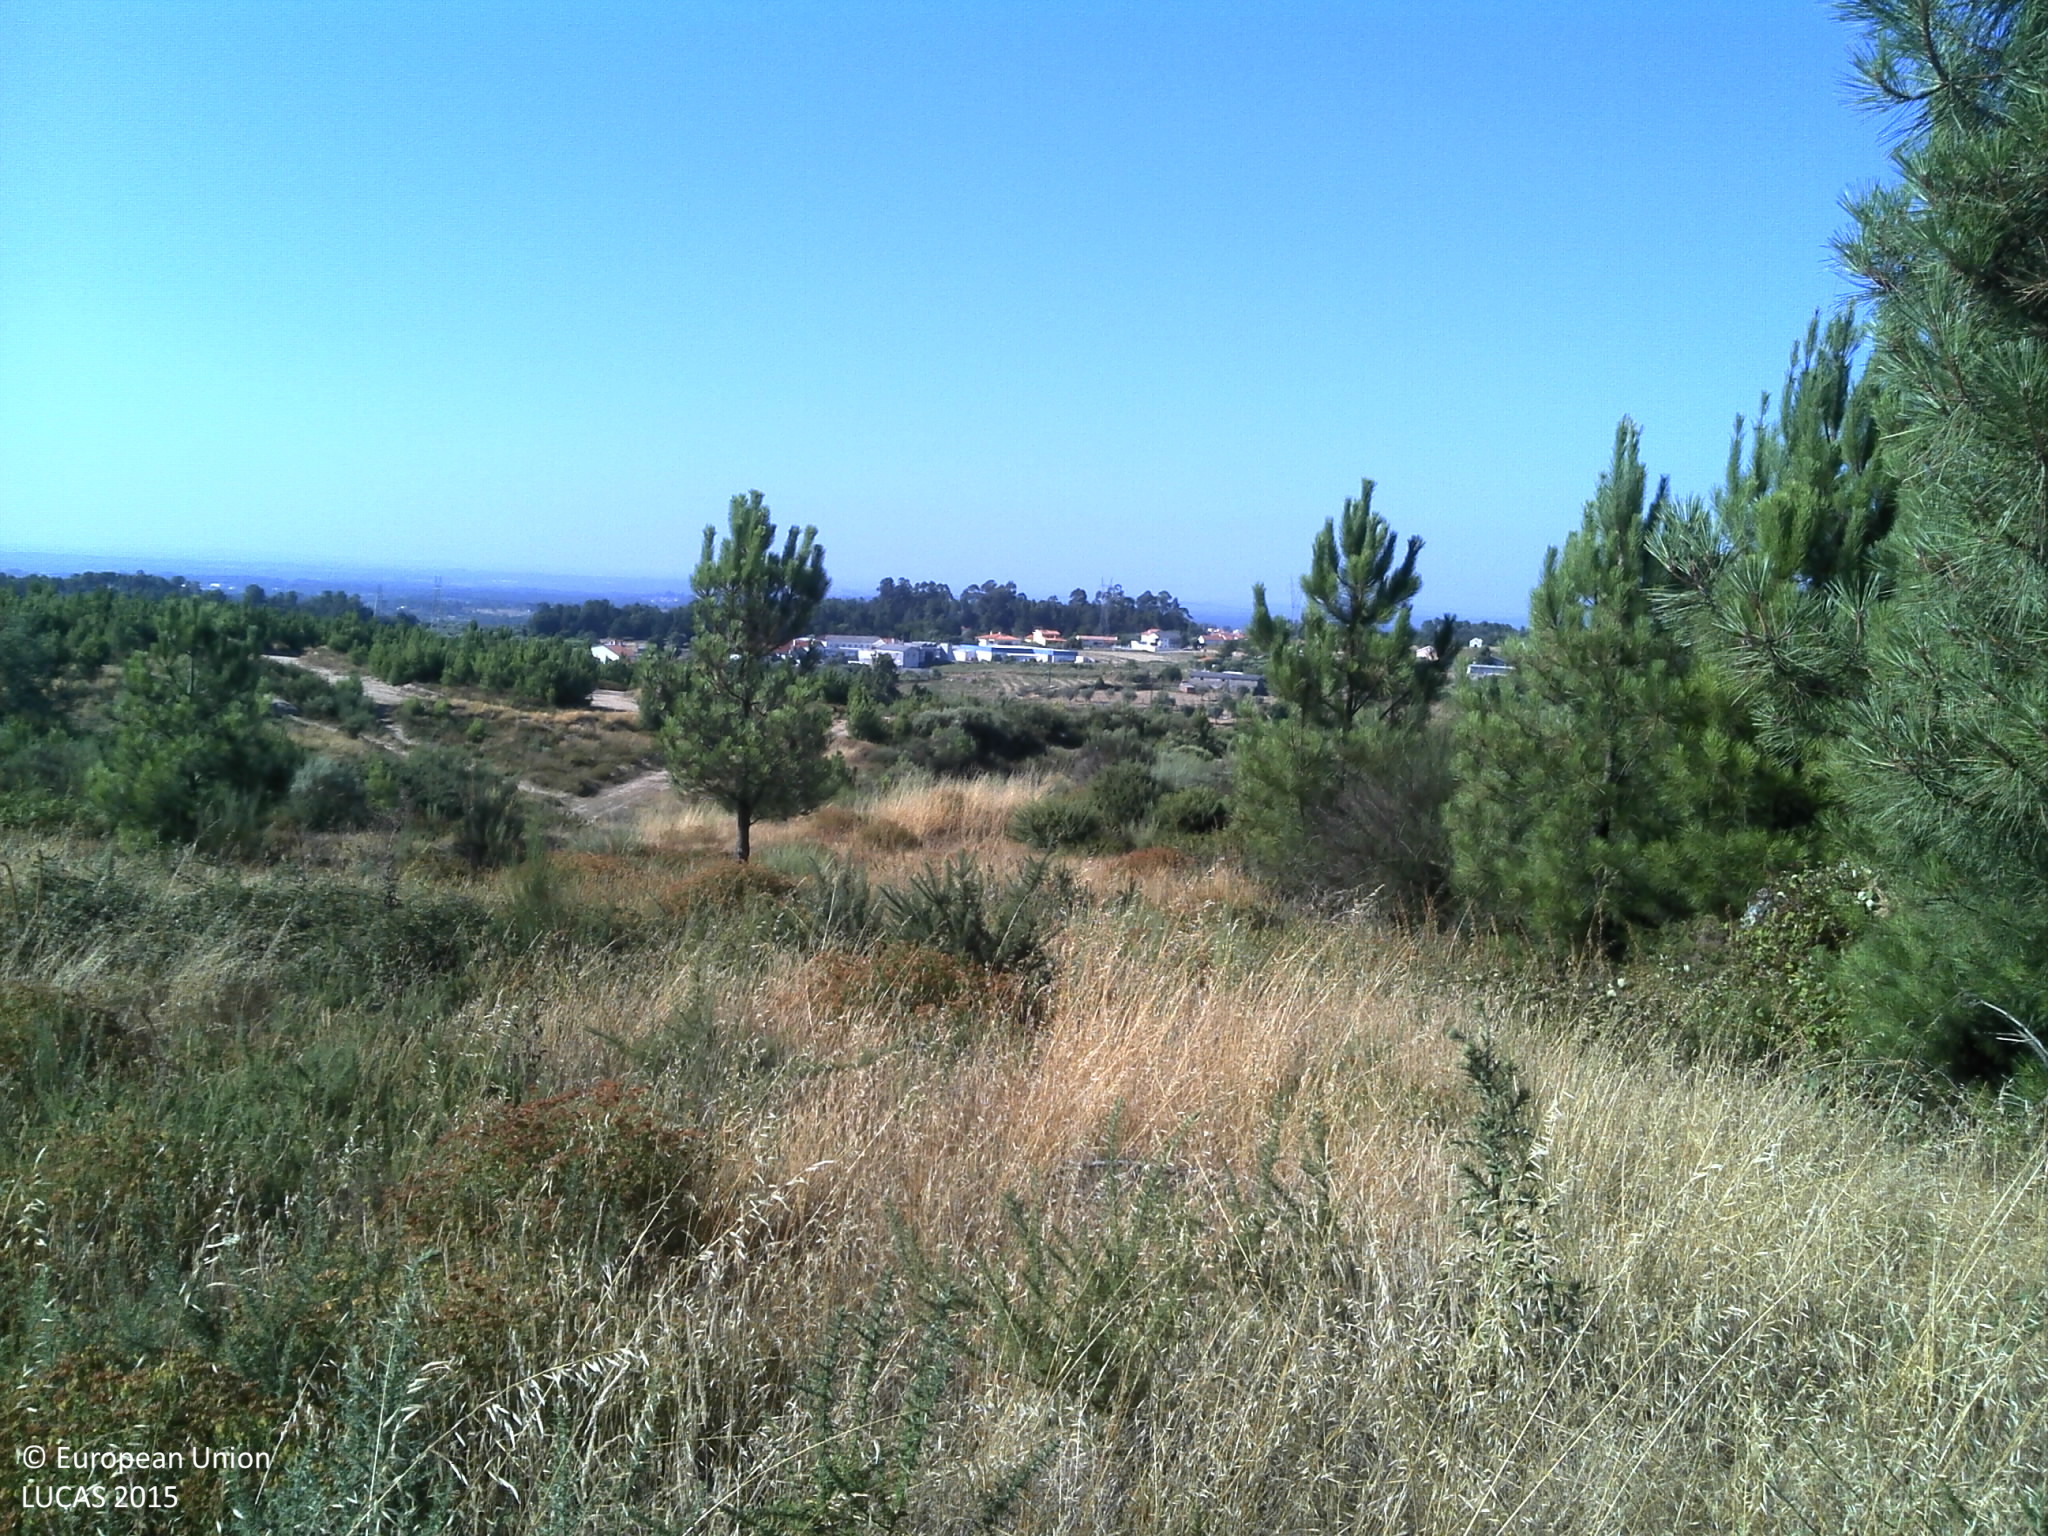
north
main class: Shrubland
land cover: Shrubland with sparse tree cover
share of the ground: > 75 %
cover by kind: shrubs 75 %, herbaceous plants 20 %, coniferous forest trees 5 %
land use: Semi-natural and natural areas not in use
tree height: > 5 m
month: July
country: PT
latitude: 40.3673
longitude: -7.8654
